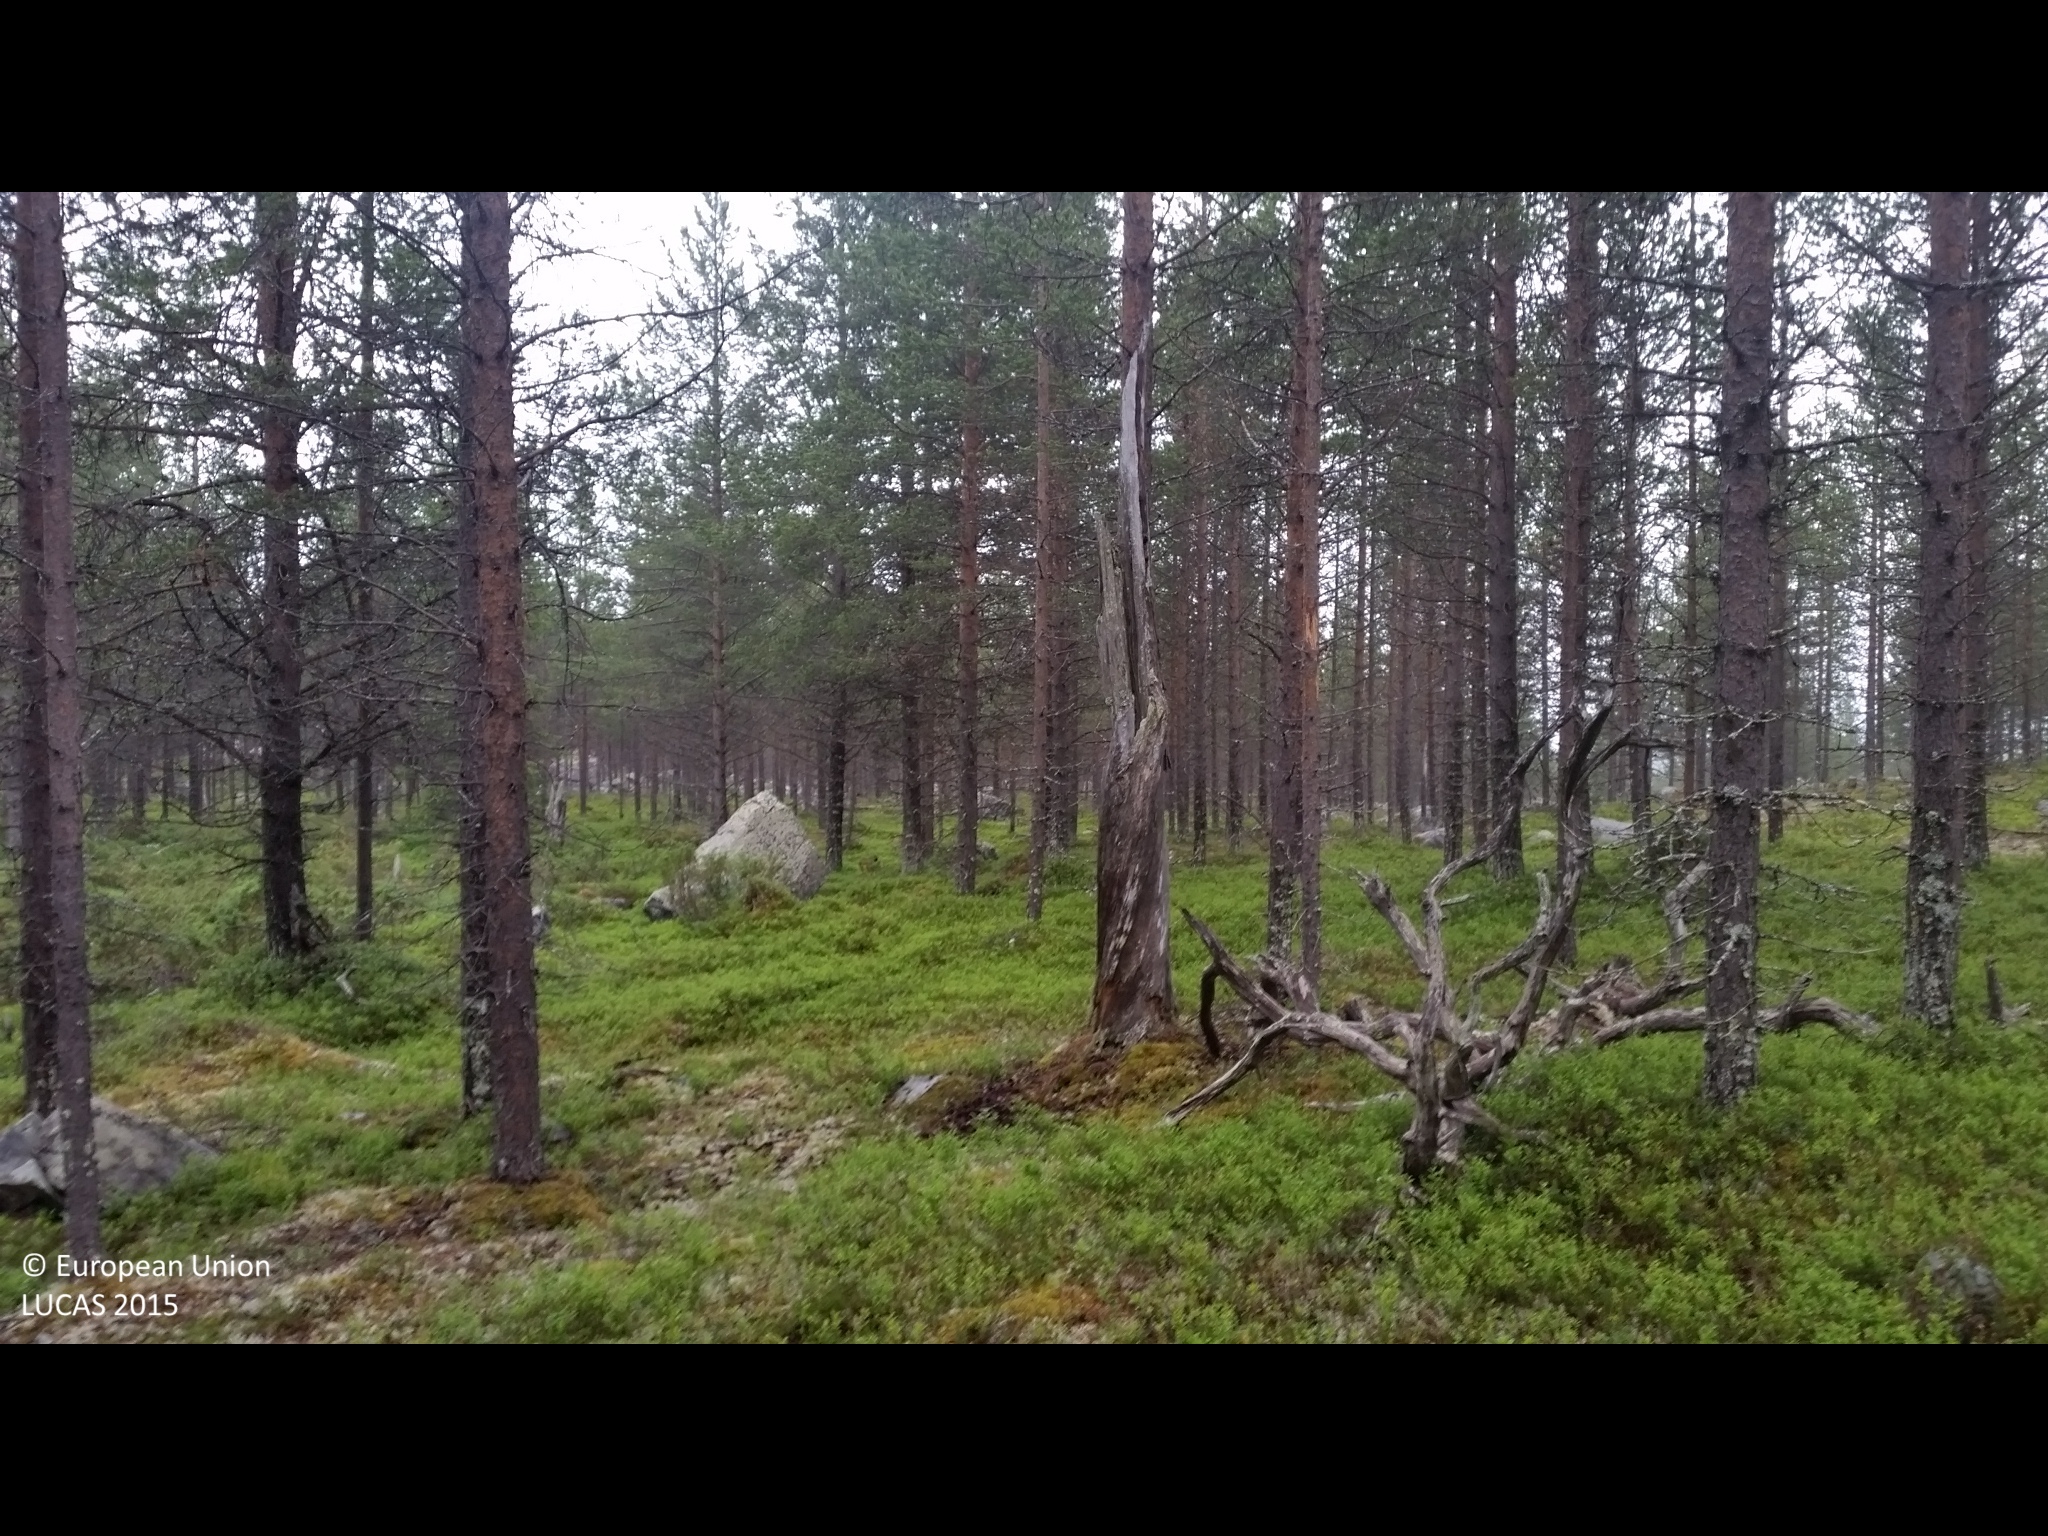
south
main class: Woodland
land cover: Pine dominated coniferous woodland
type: boreal forest
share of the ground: 50 - 75 %
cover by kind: coniferous forest trees 65 %, shrubs 25 %, lichens and mosses 5 %, consolidated bare surface 5 %
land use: Forestry
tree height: > 5 m
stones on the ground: > 50 %
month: July
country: SE
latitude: 65.8823
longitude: 18.0934
